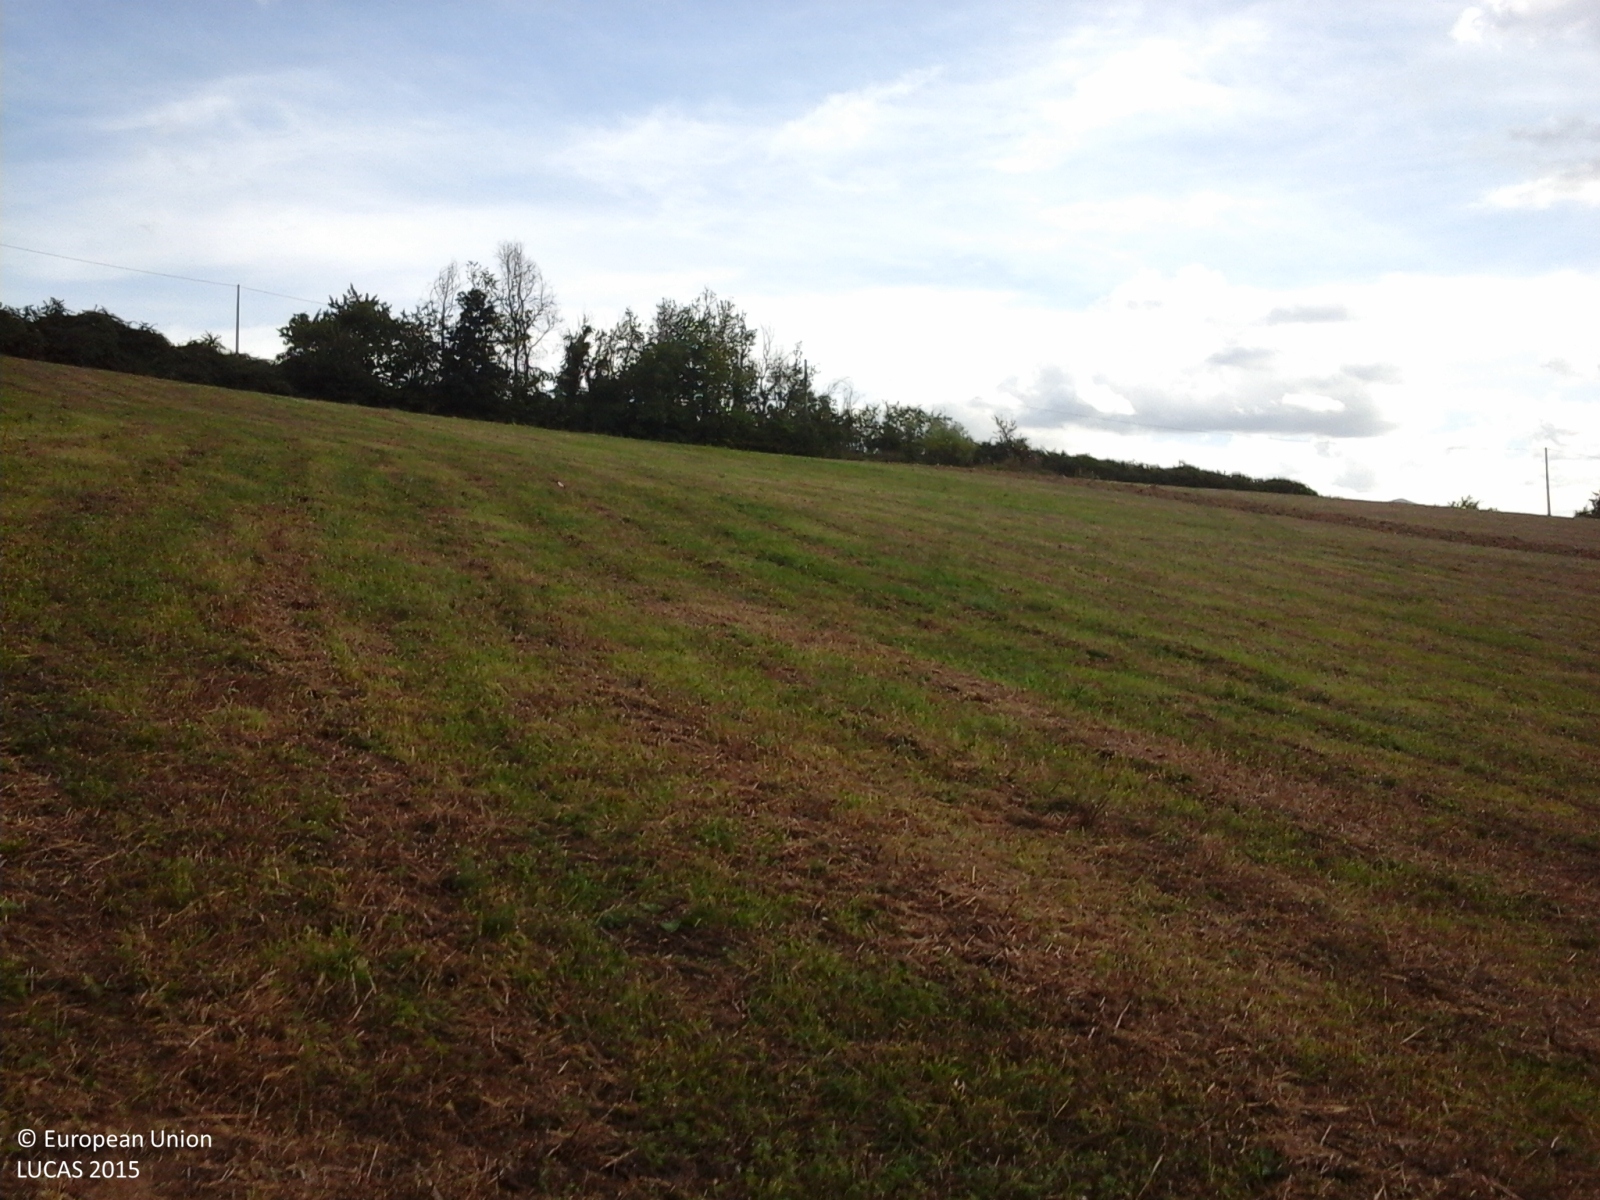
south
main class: Cropland
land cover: Durum wheat
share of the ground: < 10 %
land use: Agriculture (excluding fallow land and kitchen gardens)
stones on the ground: 25 - 50 %
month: September
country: IT
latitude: 43.3138
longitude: 13.0128
